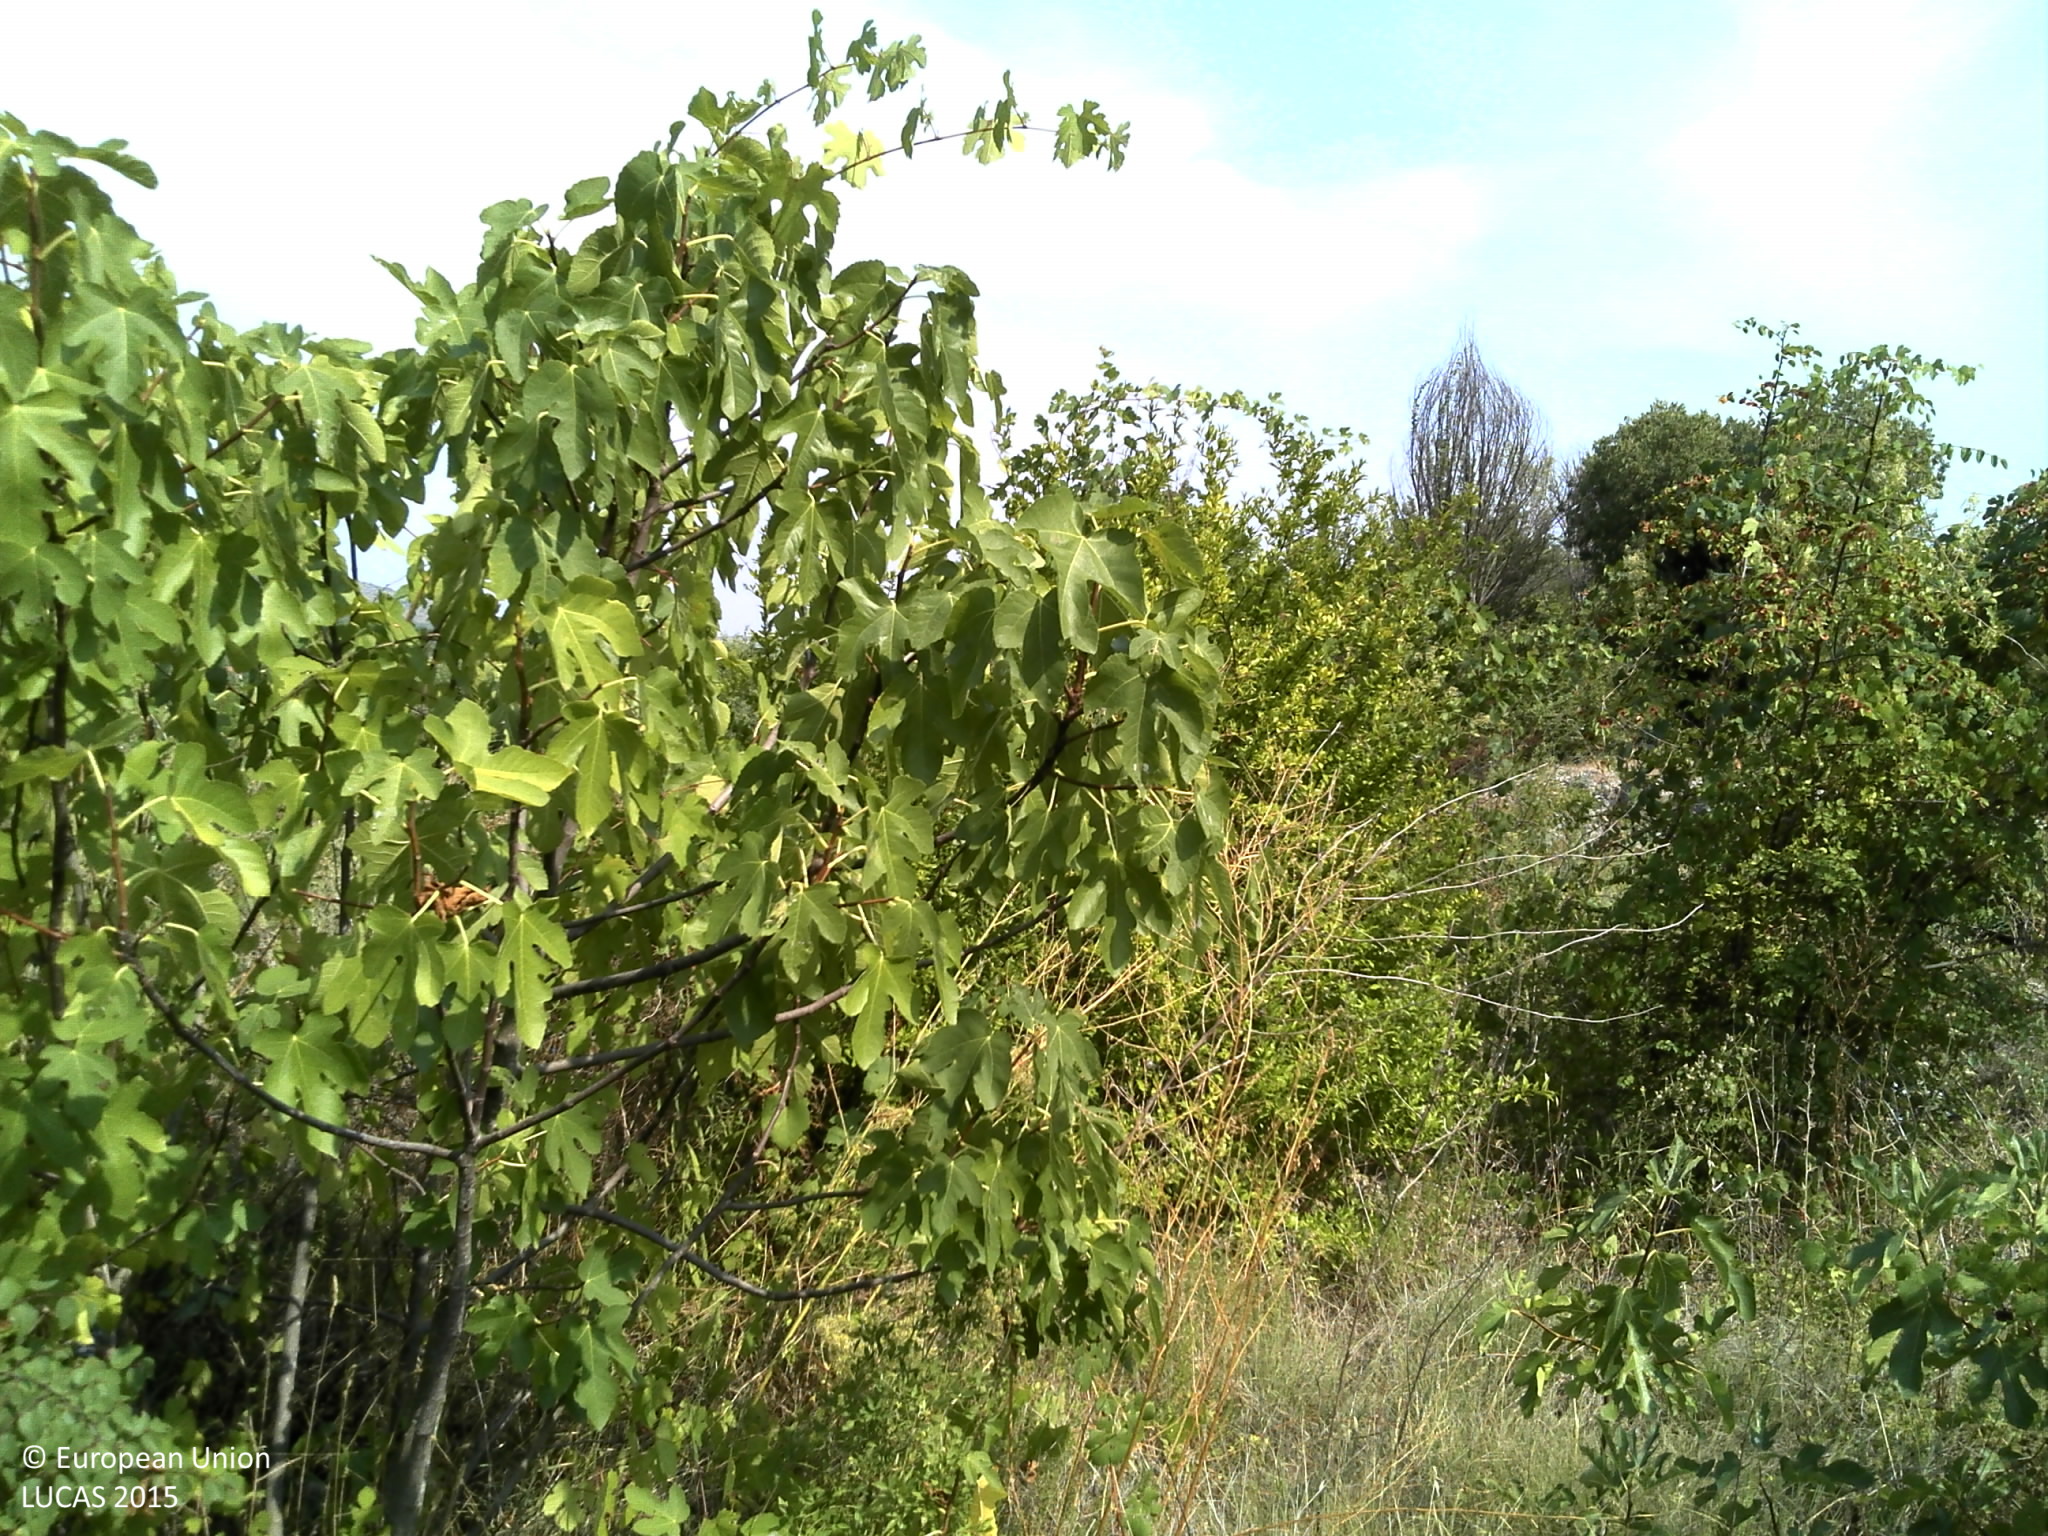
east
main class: Cropland
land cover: Other fruit trees and berries
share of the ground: 50 - 75 %
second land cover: Spontaneously vegetated surfaces
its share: > 75 %
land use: Agriculture (excluding fallow land and kitchen gardens)
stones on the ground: > 50 %
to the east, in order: Other fruit trees and berries; Spontaneously vegetated surfaces; Rocks and stones; Inland marshes; Inland fresh running water; Inland marshes
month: August
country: HR
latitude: 43.0918
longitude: 17.6202
